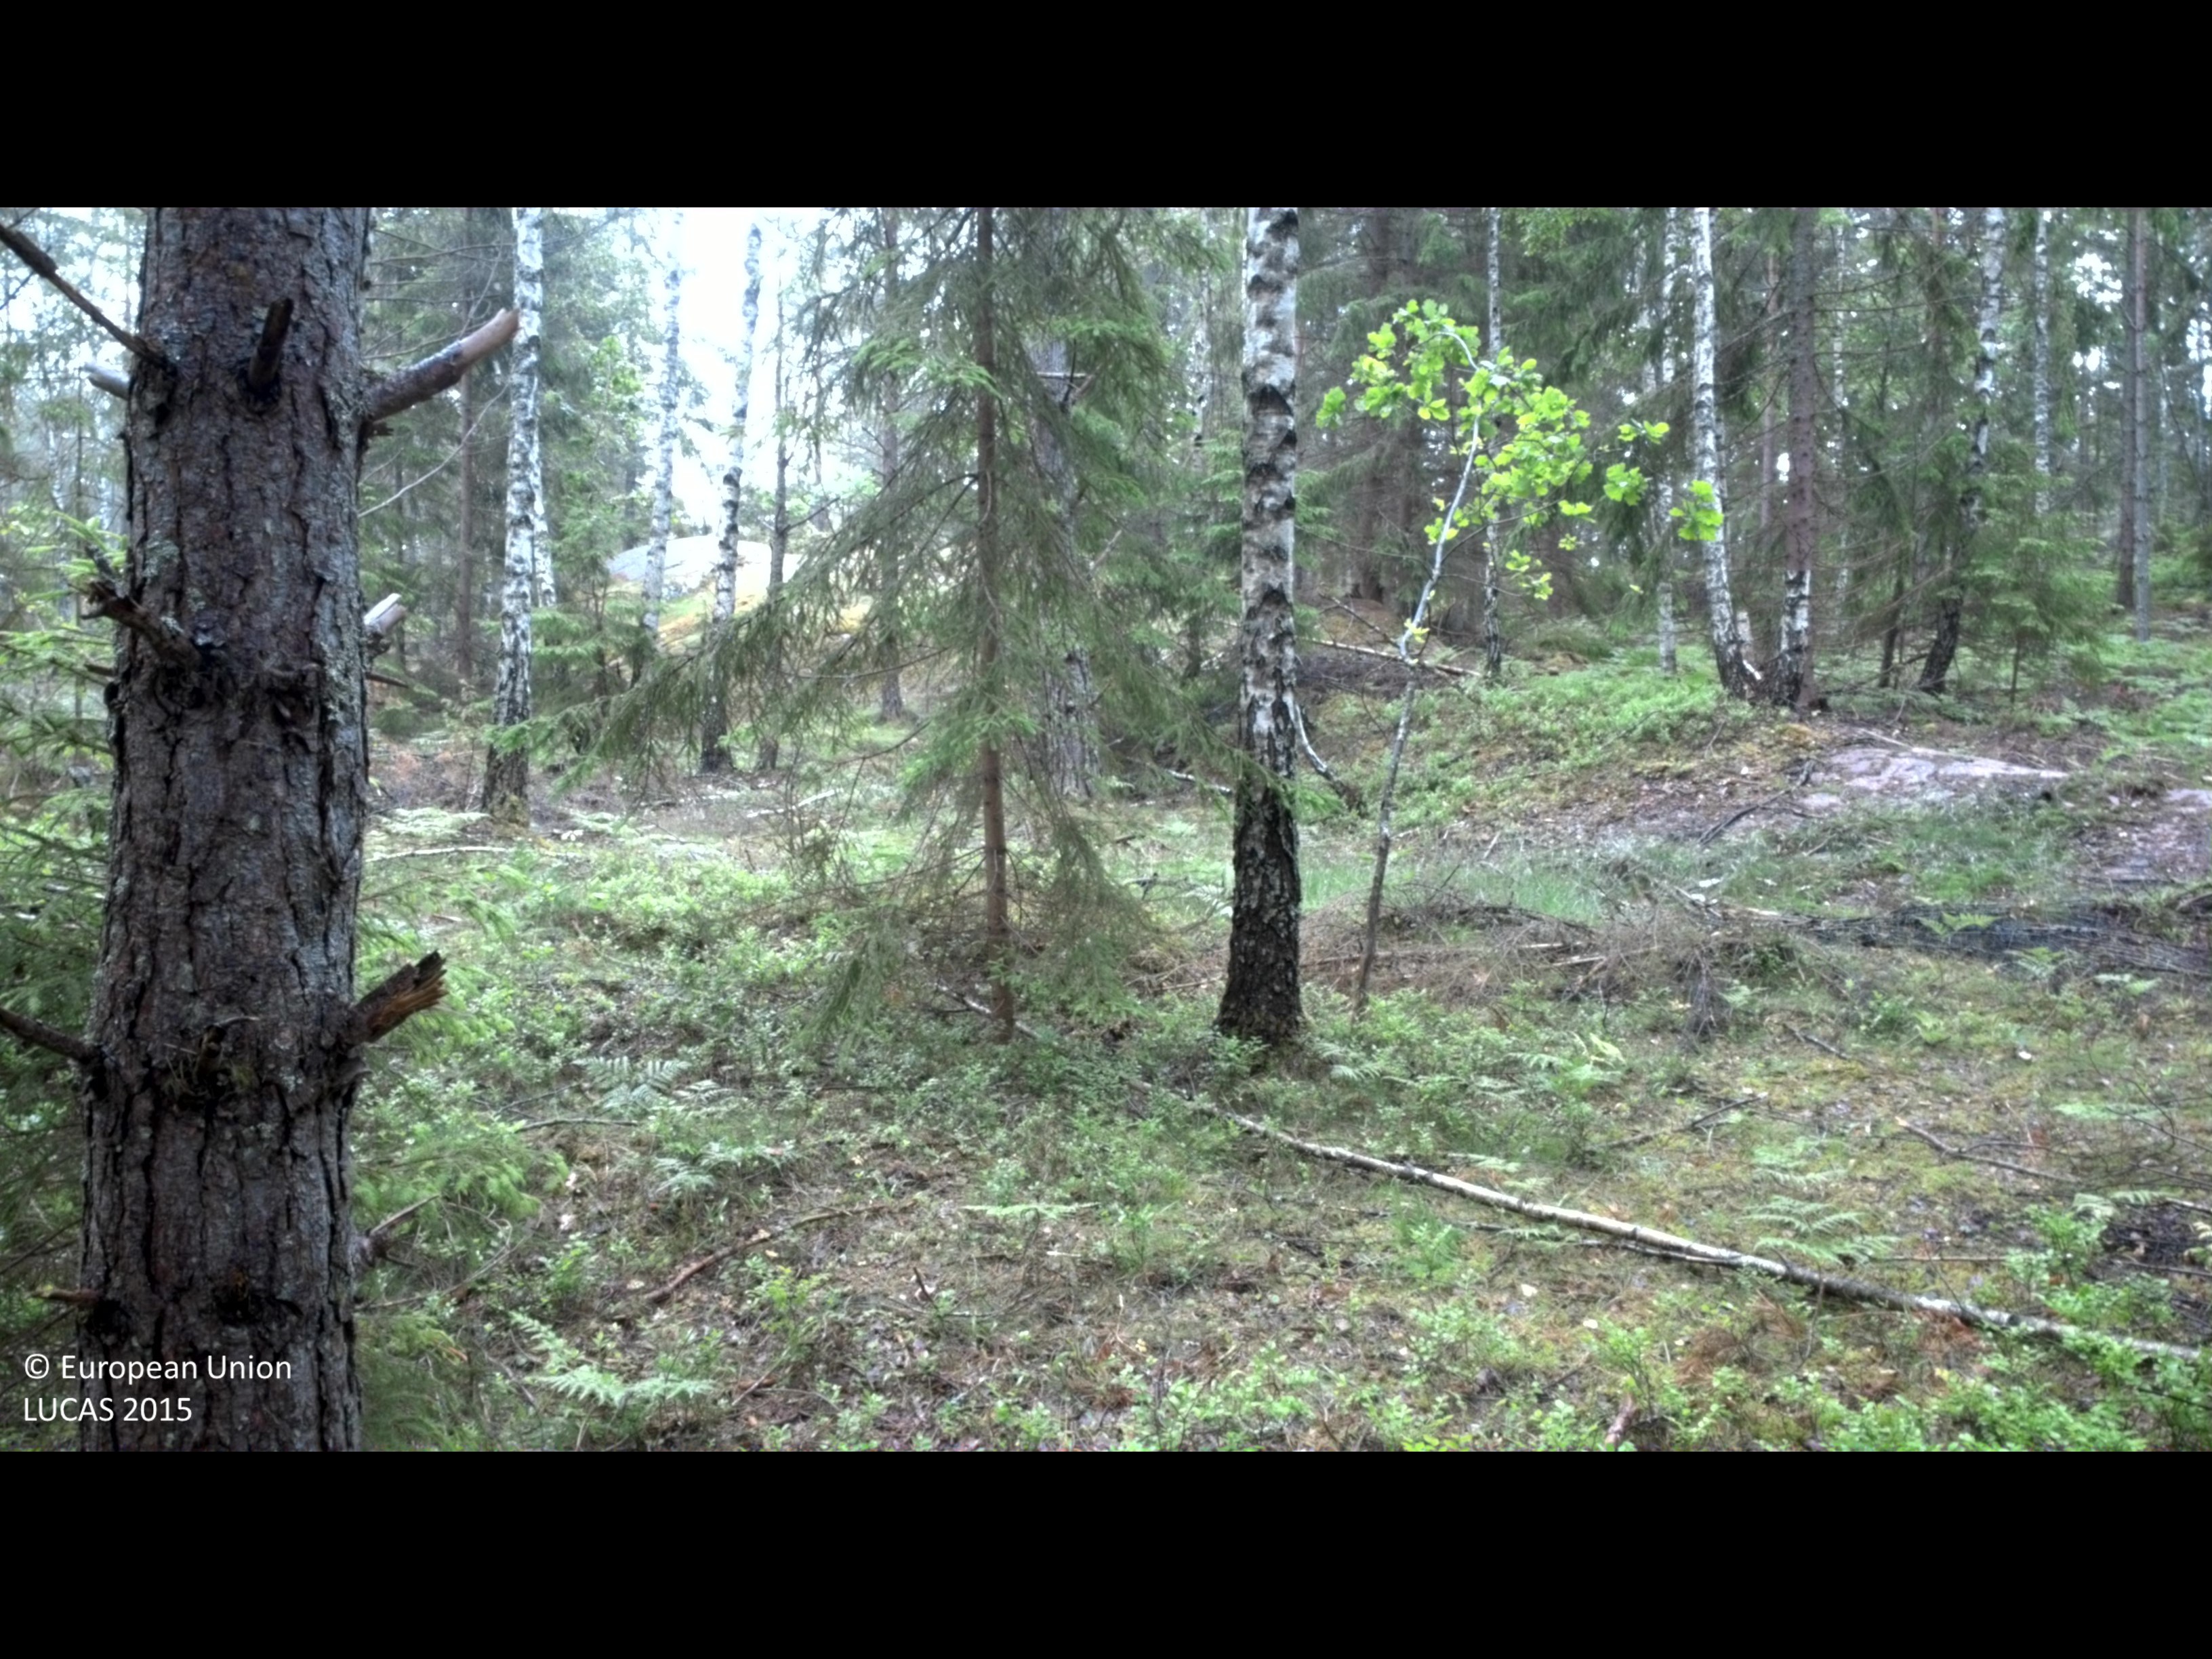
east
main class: Woodland
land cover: Spruce dominated mixed woodland
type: boreal forest
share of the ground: 50 - 75 %
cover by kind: coniferous forest trees 35 %, broadleaved forest trees 30 %, shrubs 15 %, lichens and mosses 10 %, unconsolidated bare surface 10 %
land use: Forestry
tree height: > 5 m
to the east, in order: Spruce dominated mixed woodland; Other coniferous woodland; Pine dominated coniferous woodland; Other mixed woodland
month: June
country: SE
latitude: 57.9635
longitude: 16.3017
